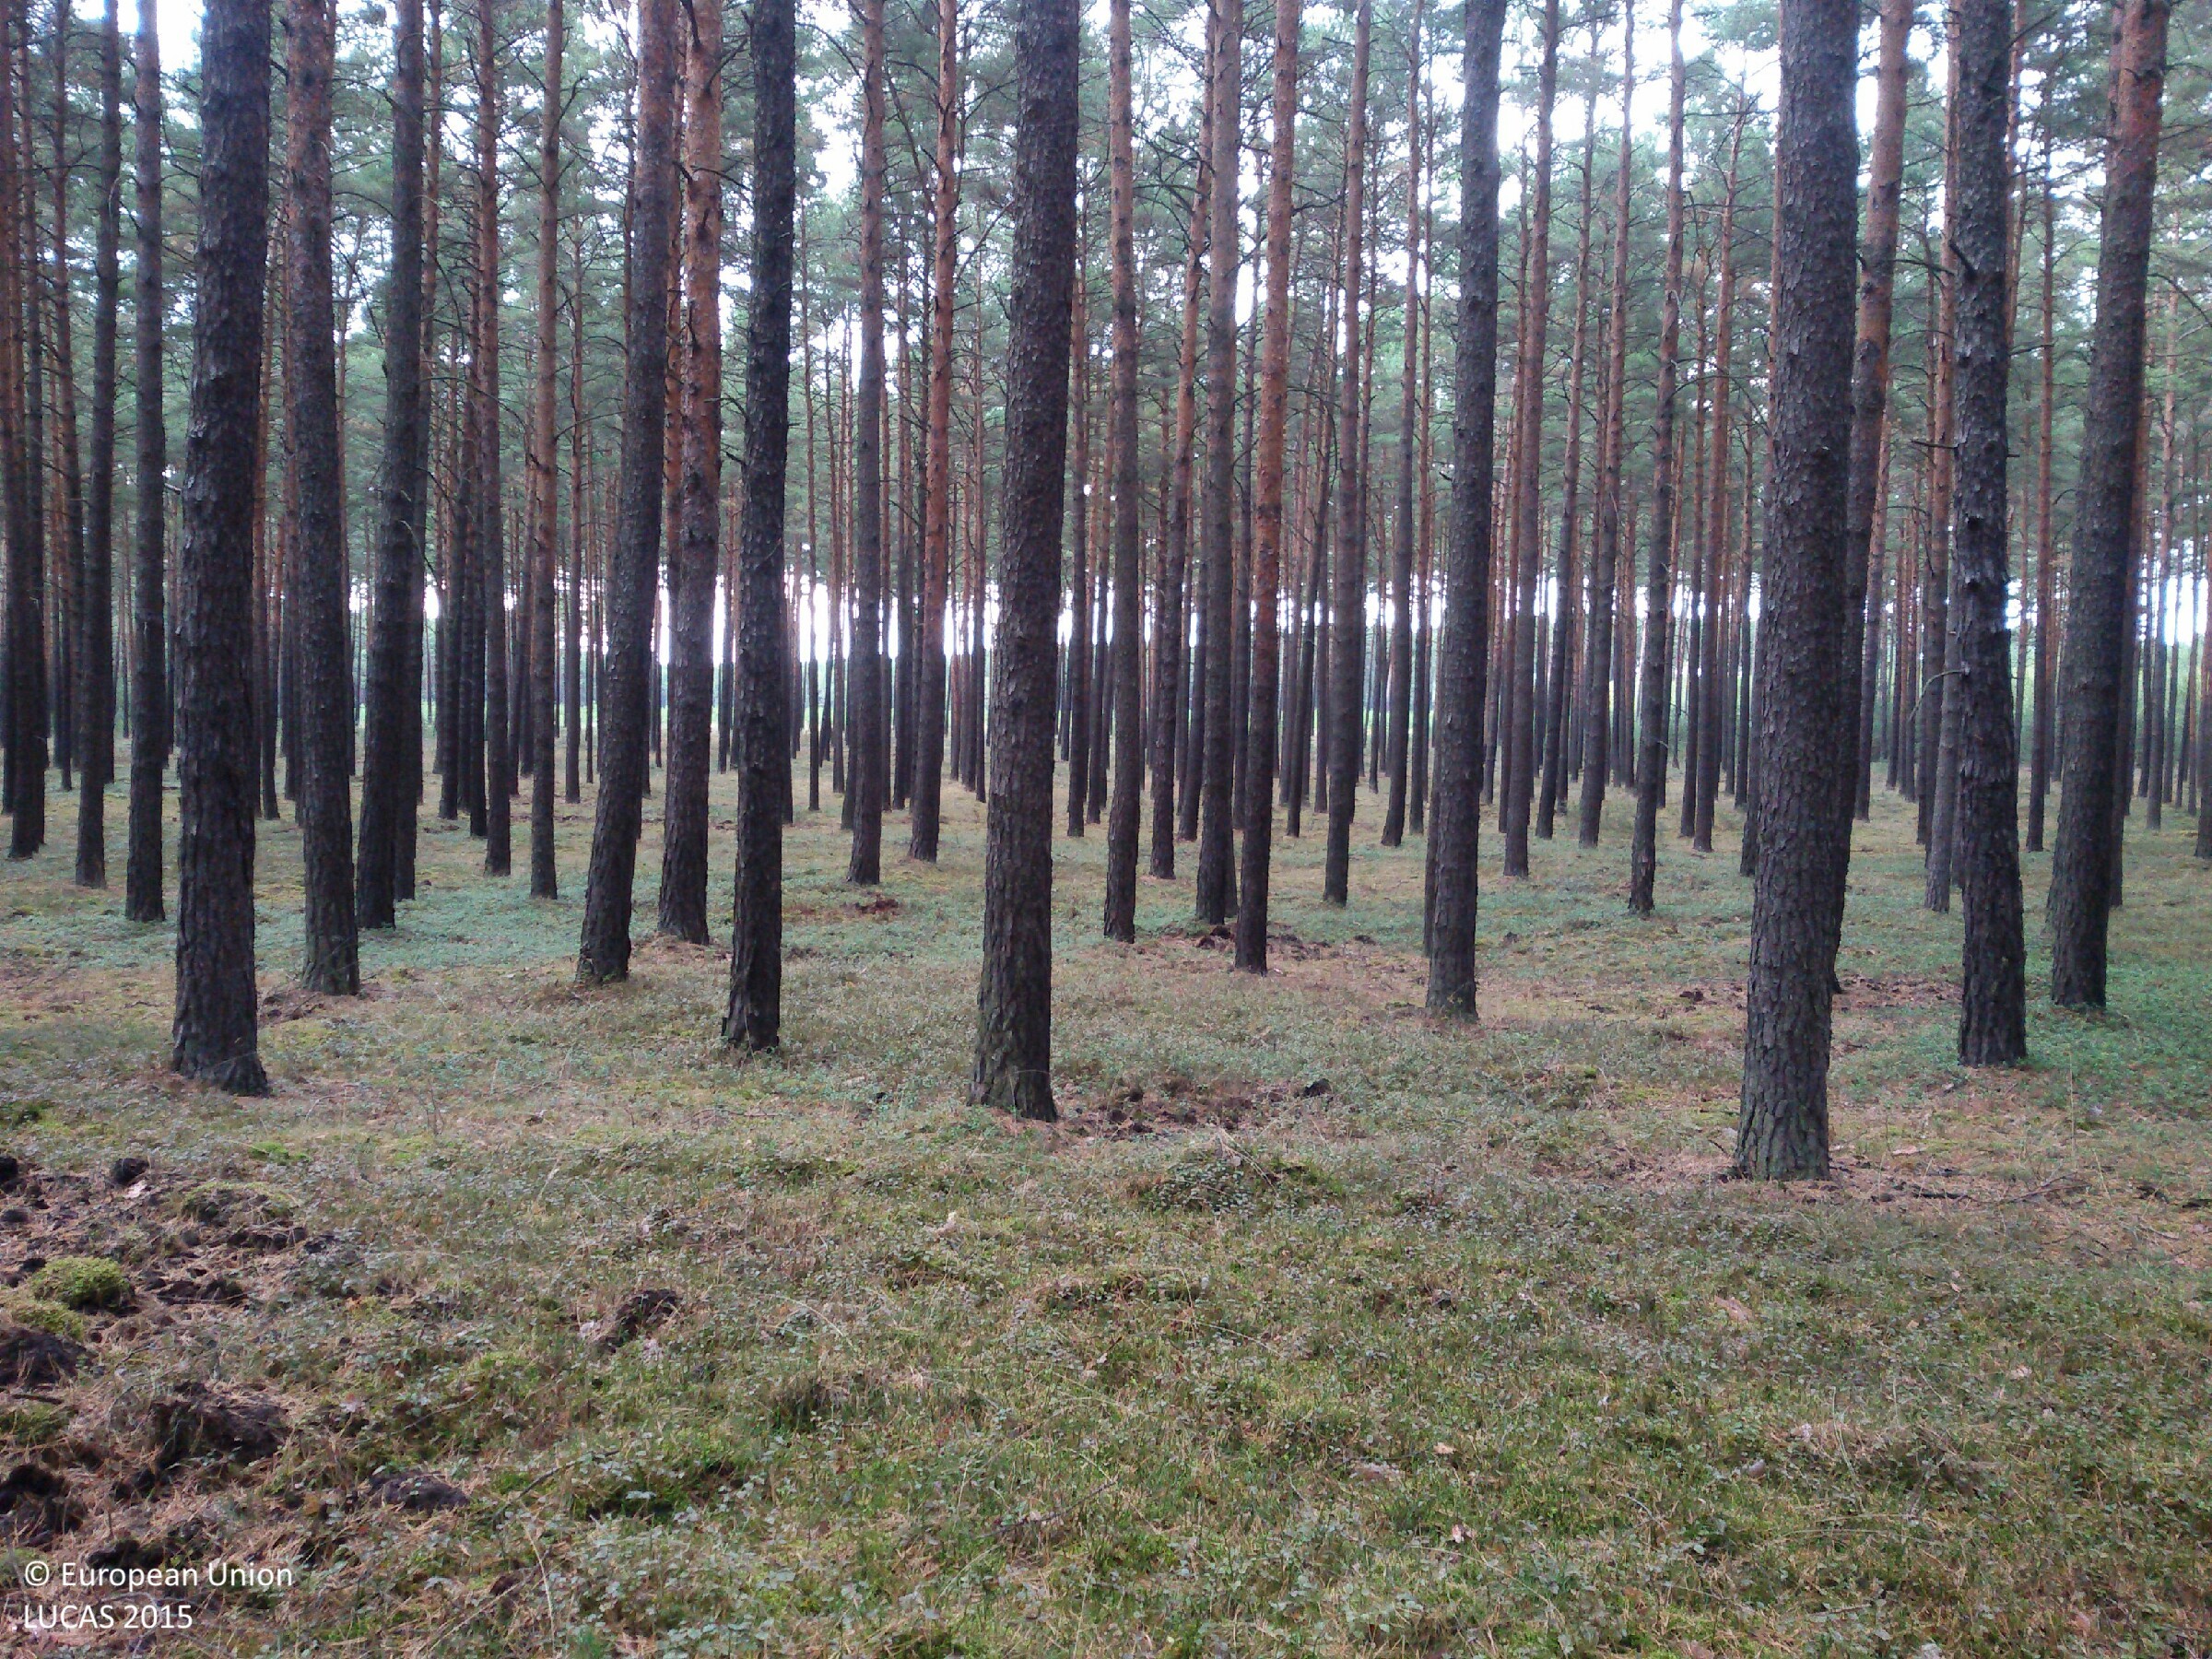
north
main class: Woodland
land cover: Pine dominated coniferous woodland
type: hemiboreal forest and nemoral coniferous forest and mixed broadleaved-coniferous forest
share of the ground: > 75 %
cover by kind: coniferous forest trees 85 %, lichens and mosses 10 %, herbaceous plants 5 %
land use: Forestry
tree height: > 5 m
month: September
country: PL
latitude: 51.8168
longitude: 14.6877
